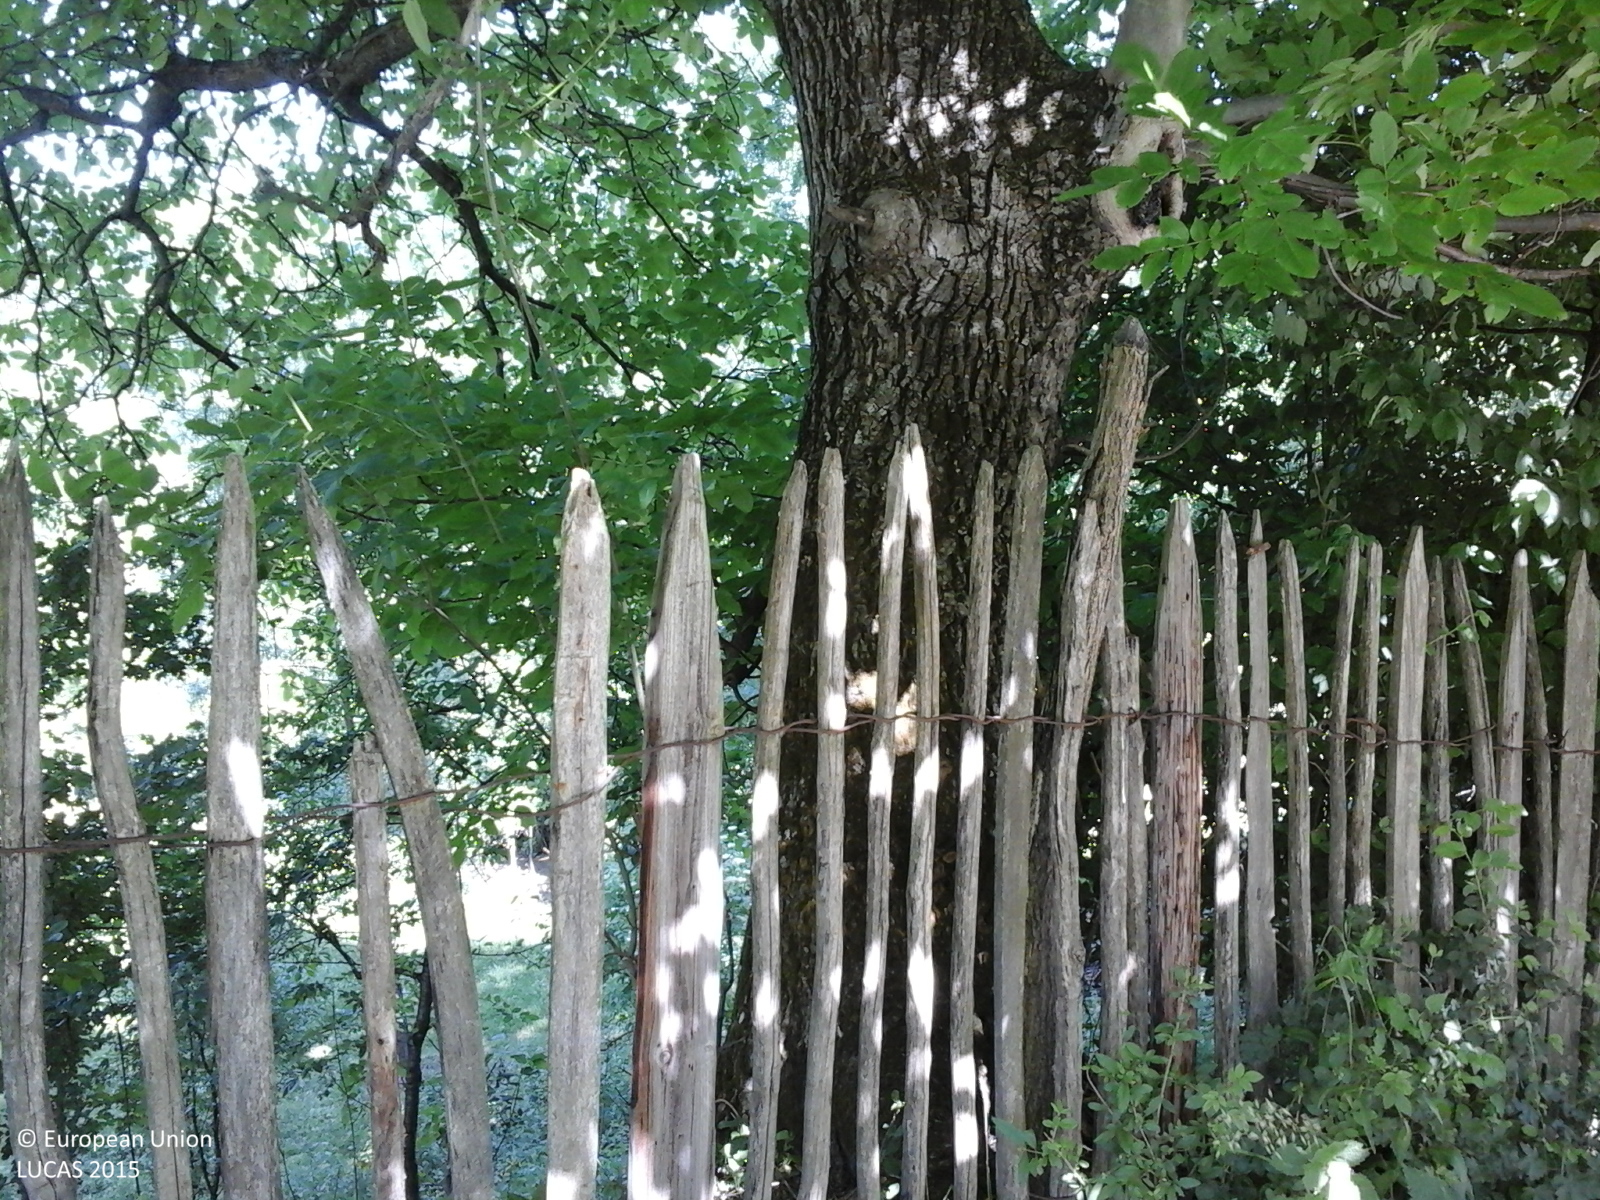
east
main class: Grassland
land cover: Grassland with sparse tree/shrub cover
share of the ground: > 75 %
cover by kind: herbaceous plants 85 %, shrubs 10 %, broadleaved forest trees 5 %
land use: Agriculture (excluding fallow land and kitchen gardens)
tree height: > 5 m
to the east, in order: Grassland with sparse tree/shrub cover; Fences; Other fruit trees and berries; Electric lines; Abandoned hedges; Inland fresh running water; Broadleaved woodland; Grassland with sparse tree/shrub cover; Broadleaved woodland; Grassland without tree/shrub cover
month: June
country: RO
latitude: 45.1900
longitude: 25.7727
